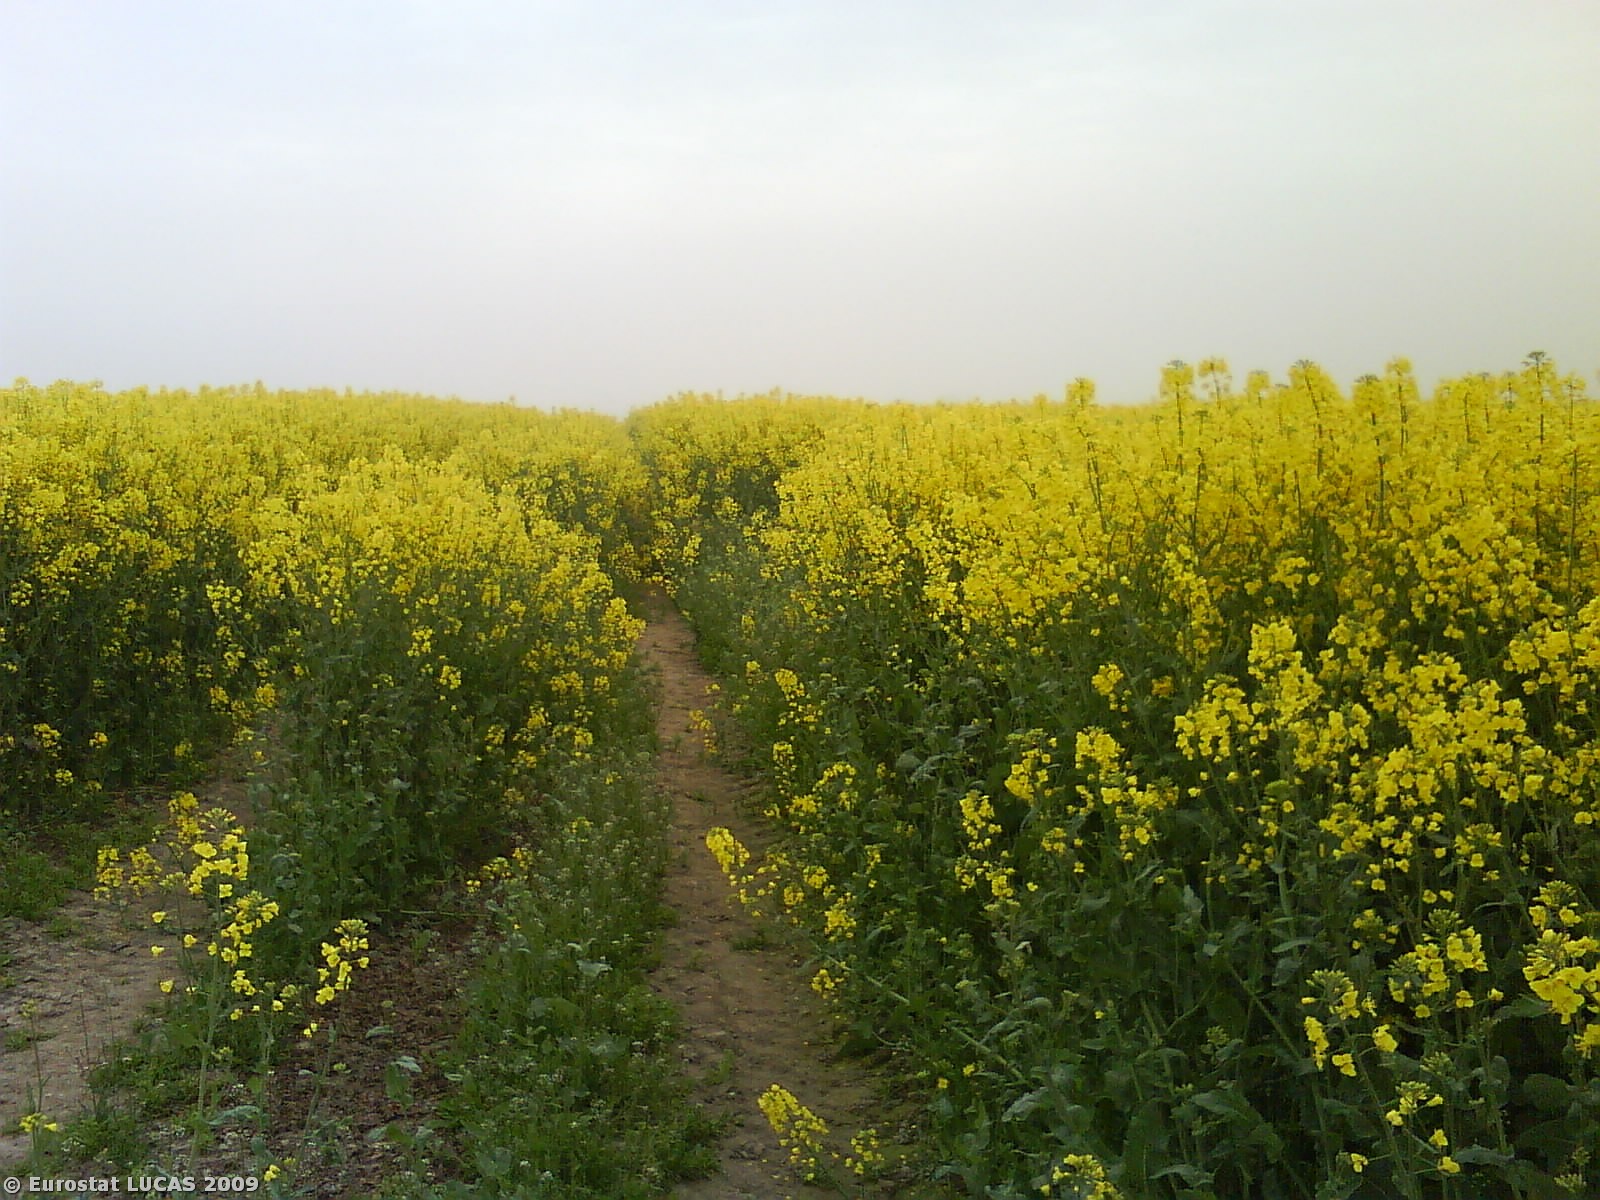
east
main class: Cropland
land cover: Rape and turnip rape
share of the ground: > 75 %
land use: Agriculture (excluding fallow land and kitchen gardens)
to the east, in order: Rape and turnip rape; Grass margins; Common wheat
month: May
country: DK
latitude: 56.3492
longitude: 10.2747
